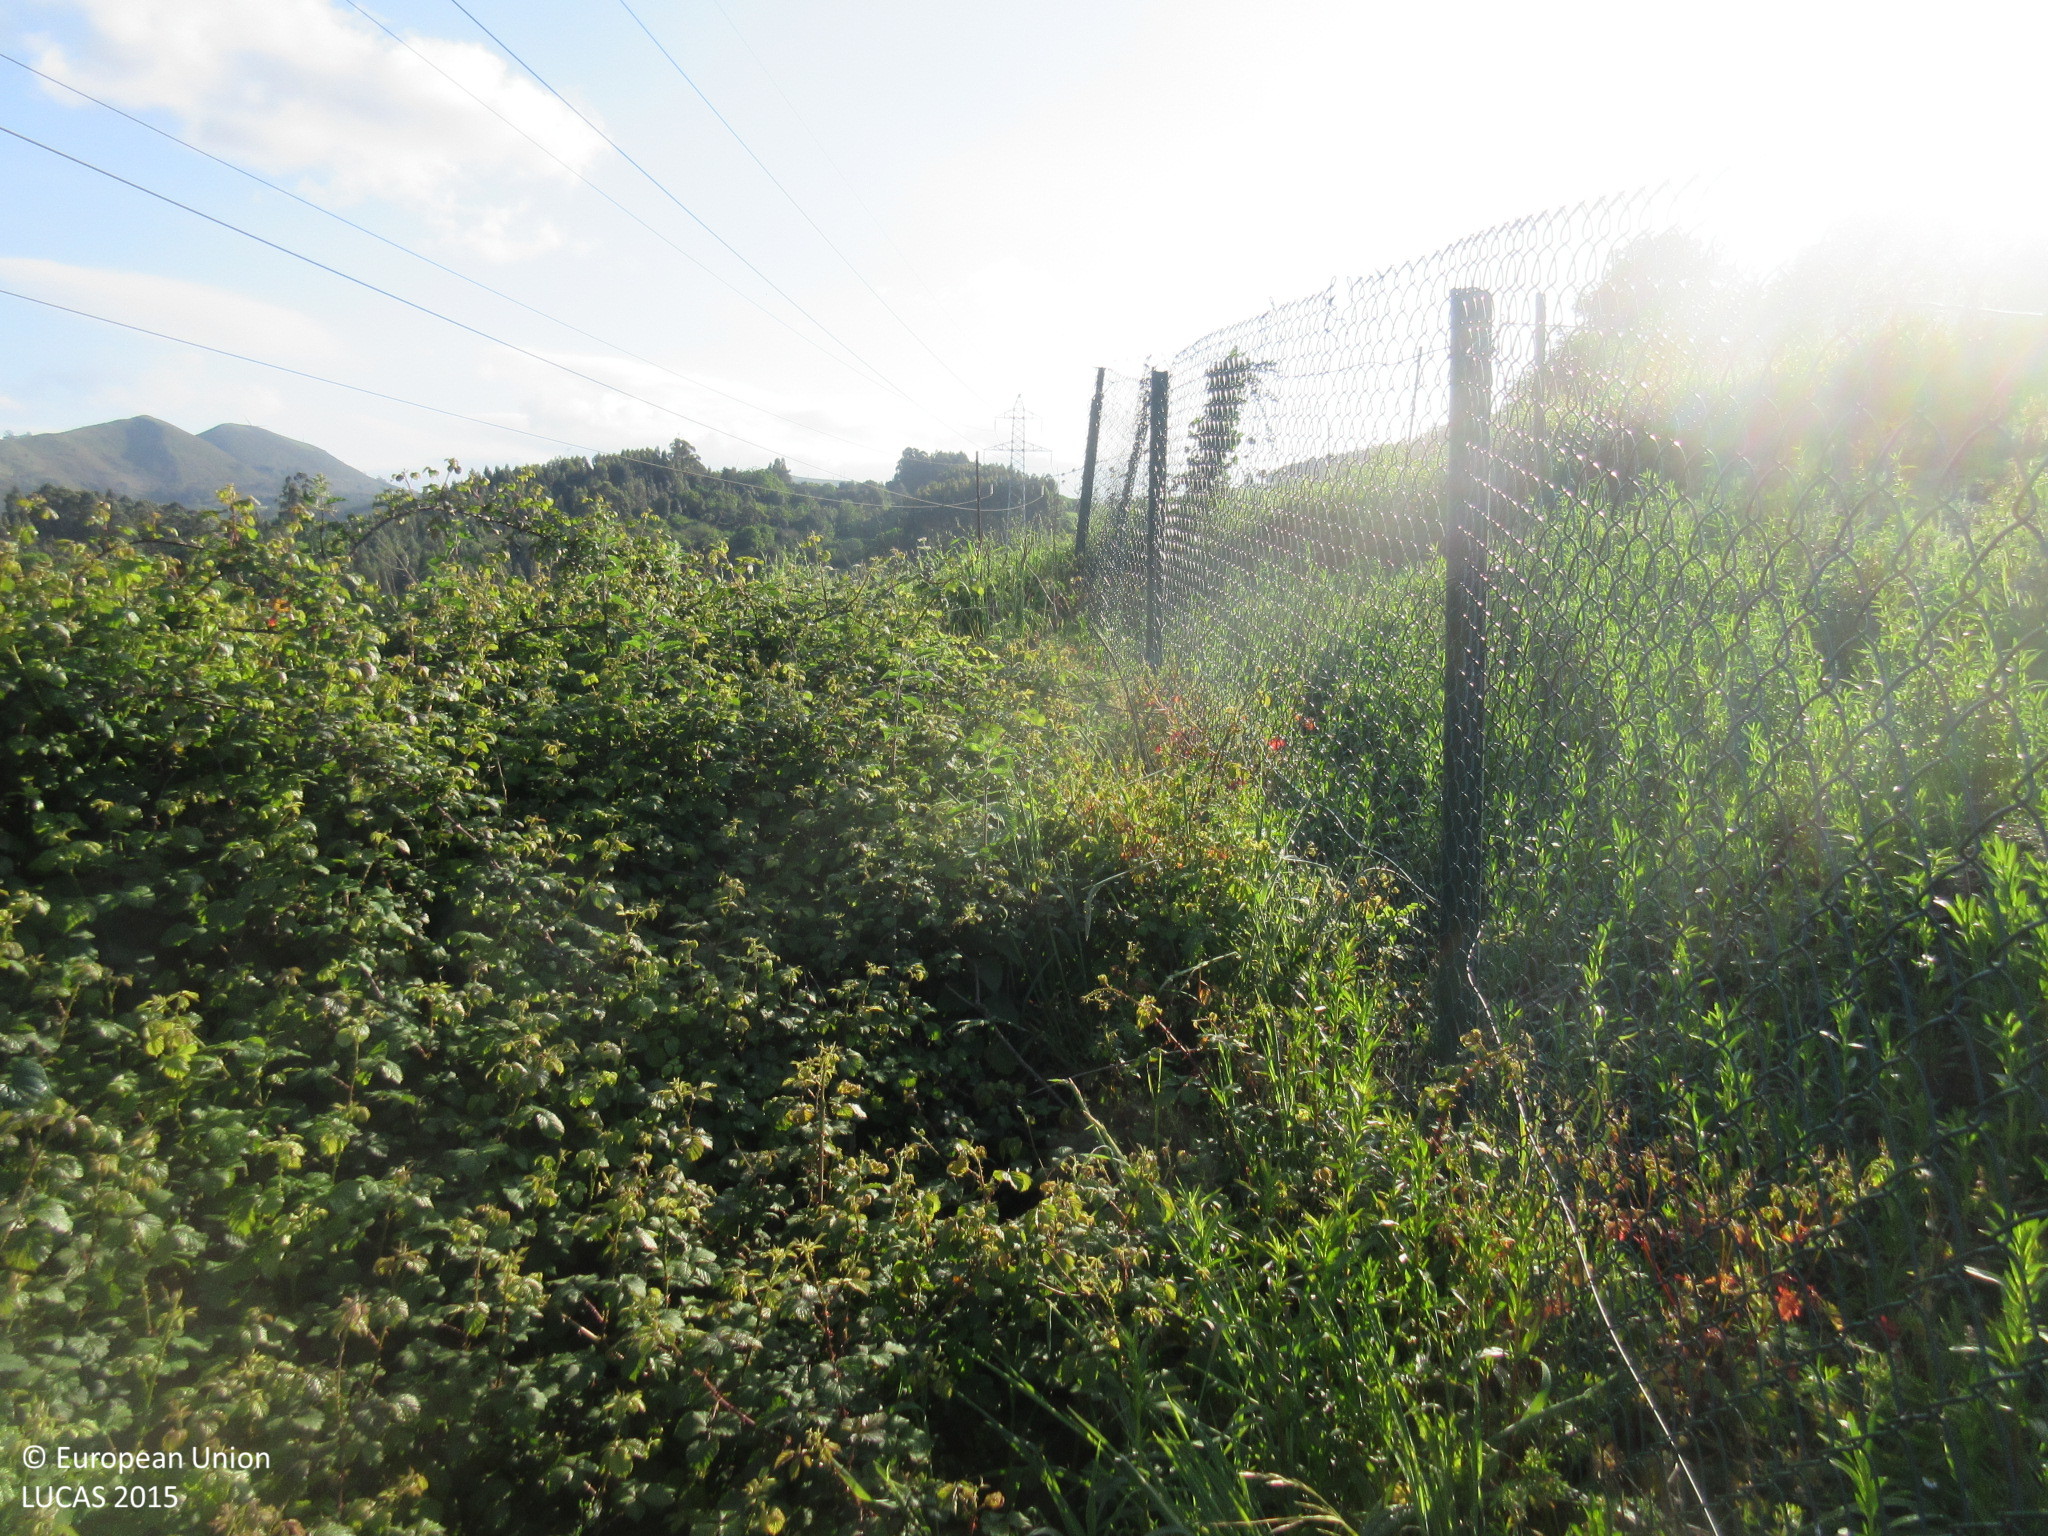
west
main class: Grassland
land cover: Grassland with sparse tree/shrub cover
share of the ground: > 75 %
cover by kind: herbaceous plants 95 %, broadleaved forest trees 5 %
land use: Agriculture (excluding fallow land and kitchen gardens)
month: May
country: ES
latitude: 43.5093
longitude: -5.9618
